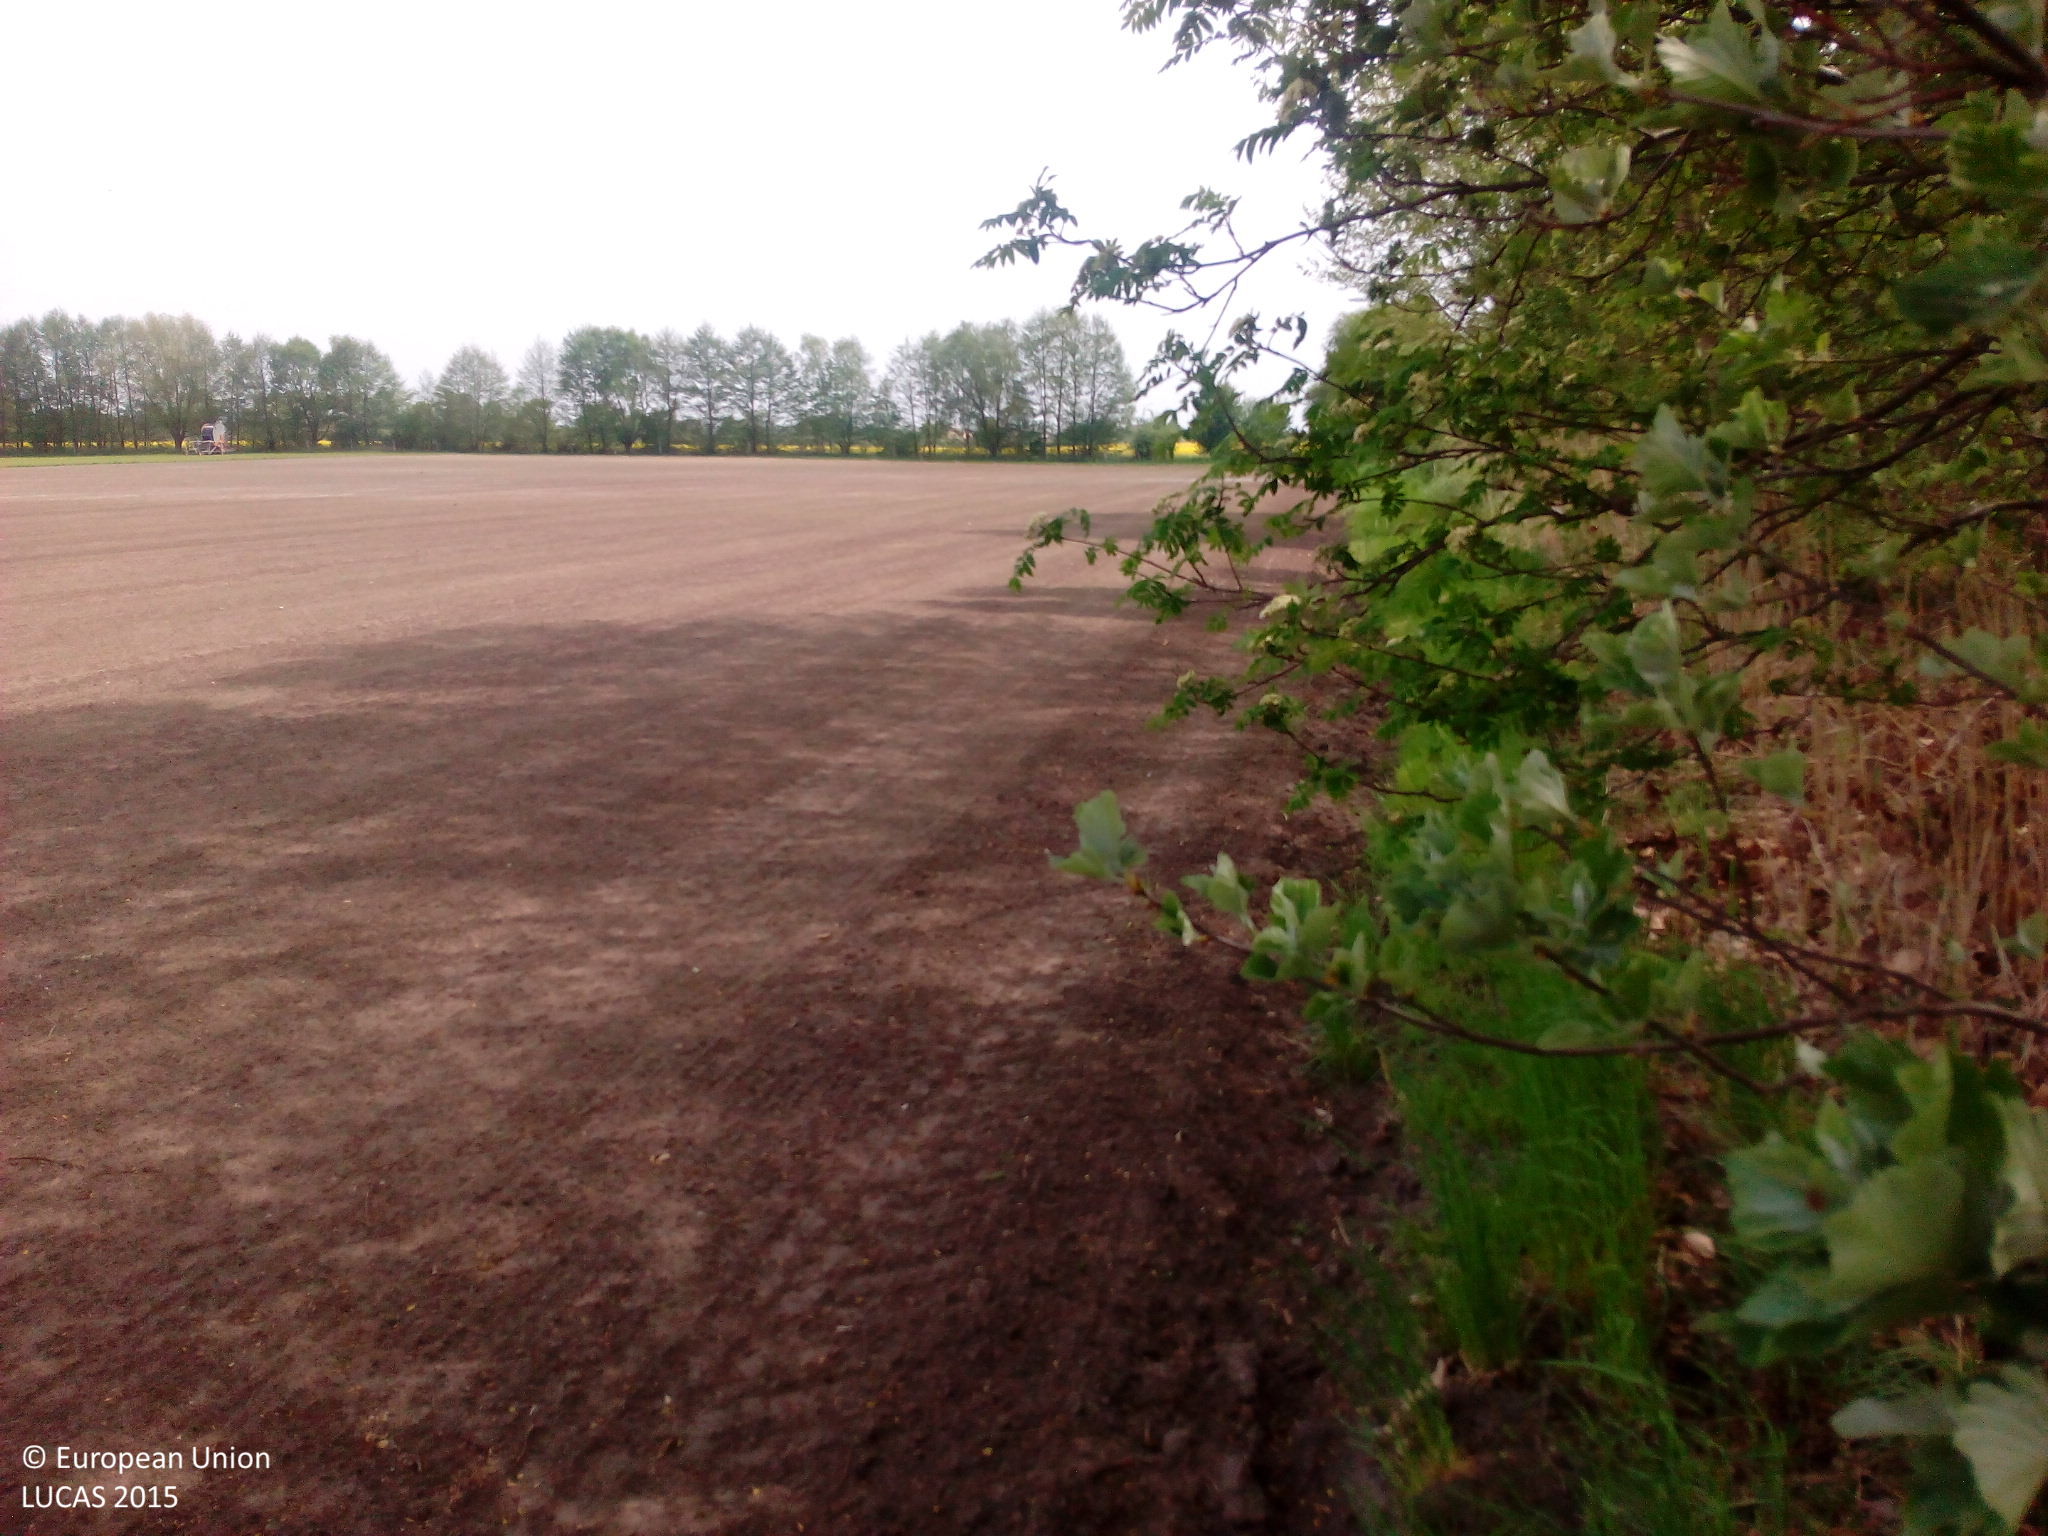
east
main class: Grassland
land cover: Grassland without tree/shrub cover
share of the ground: > 75 %
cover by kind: unconsolidated bare surface 90 %, herbaceous plants 10 %
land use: Agriculture (excluding fallow land and kitchen gardens)
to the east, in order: Grassland without tree/shrub cover; Lines of trees; Ditches and canals; Lines of trees; Grassland without tree/shrub cover; Fences; Broadleaved woodland; Ditches and canals
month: May
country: DE
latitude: 52.3176
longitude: 13.1540
